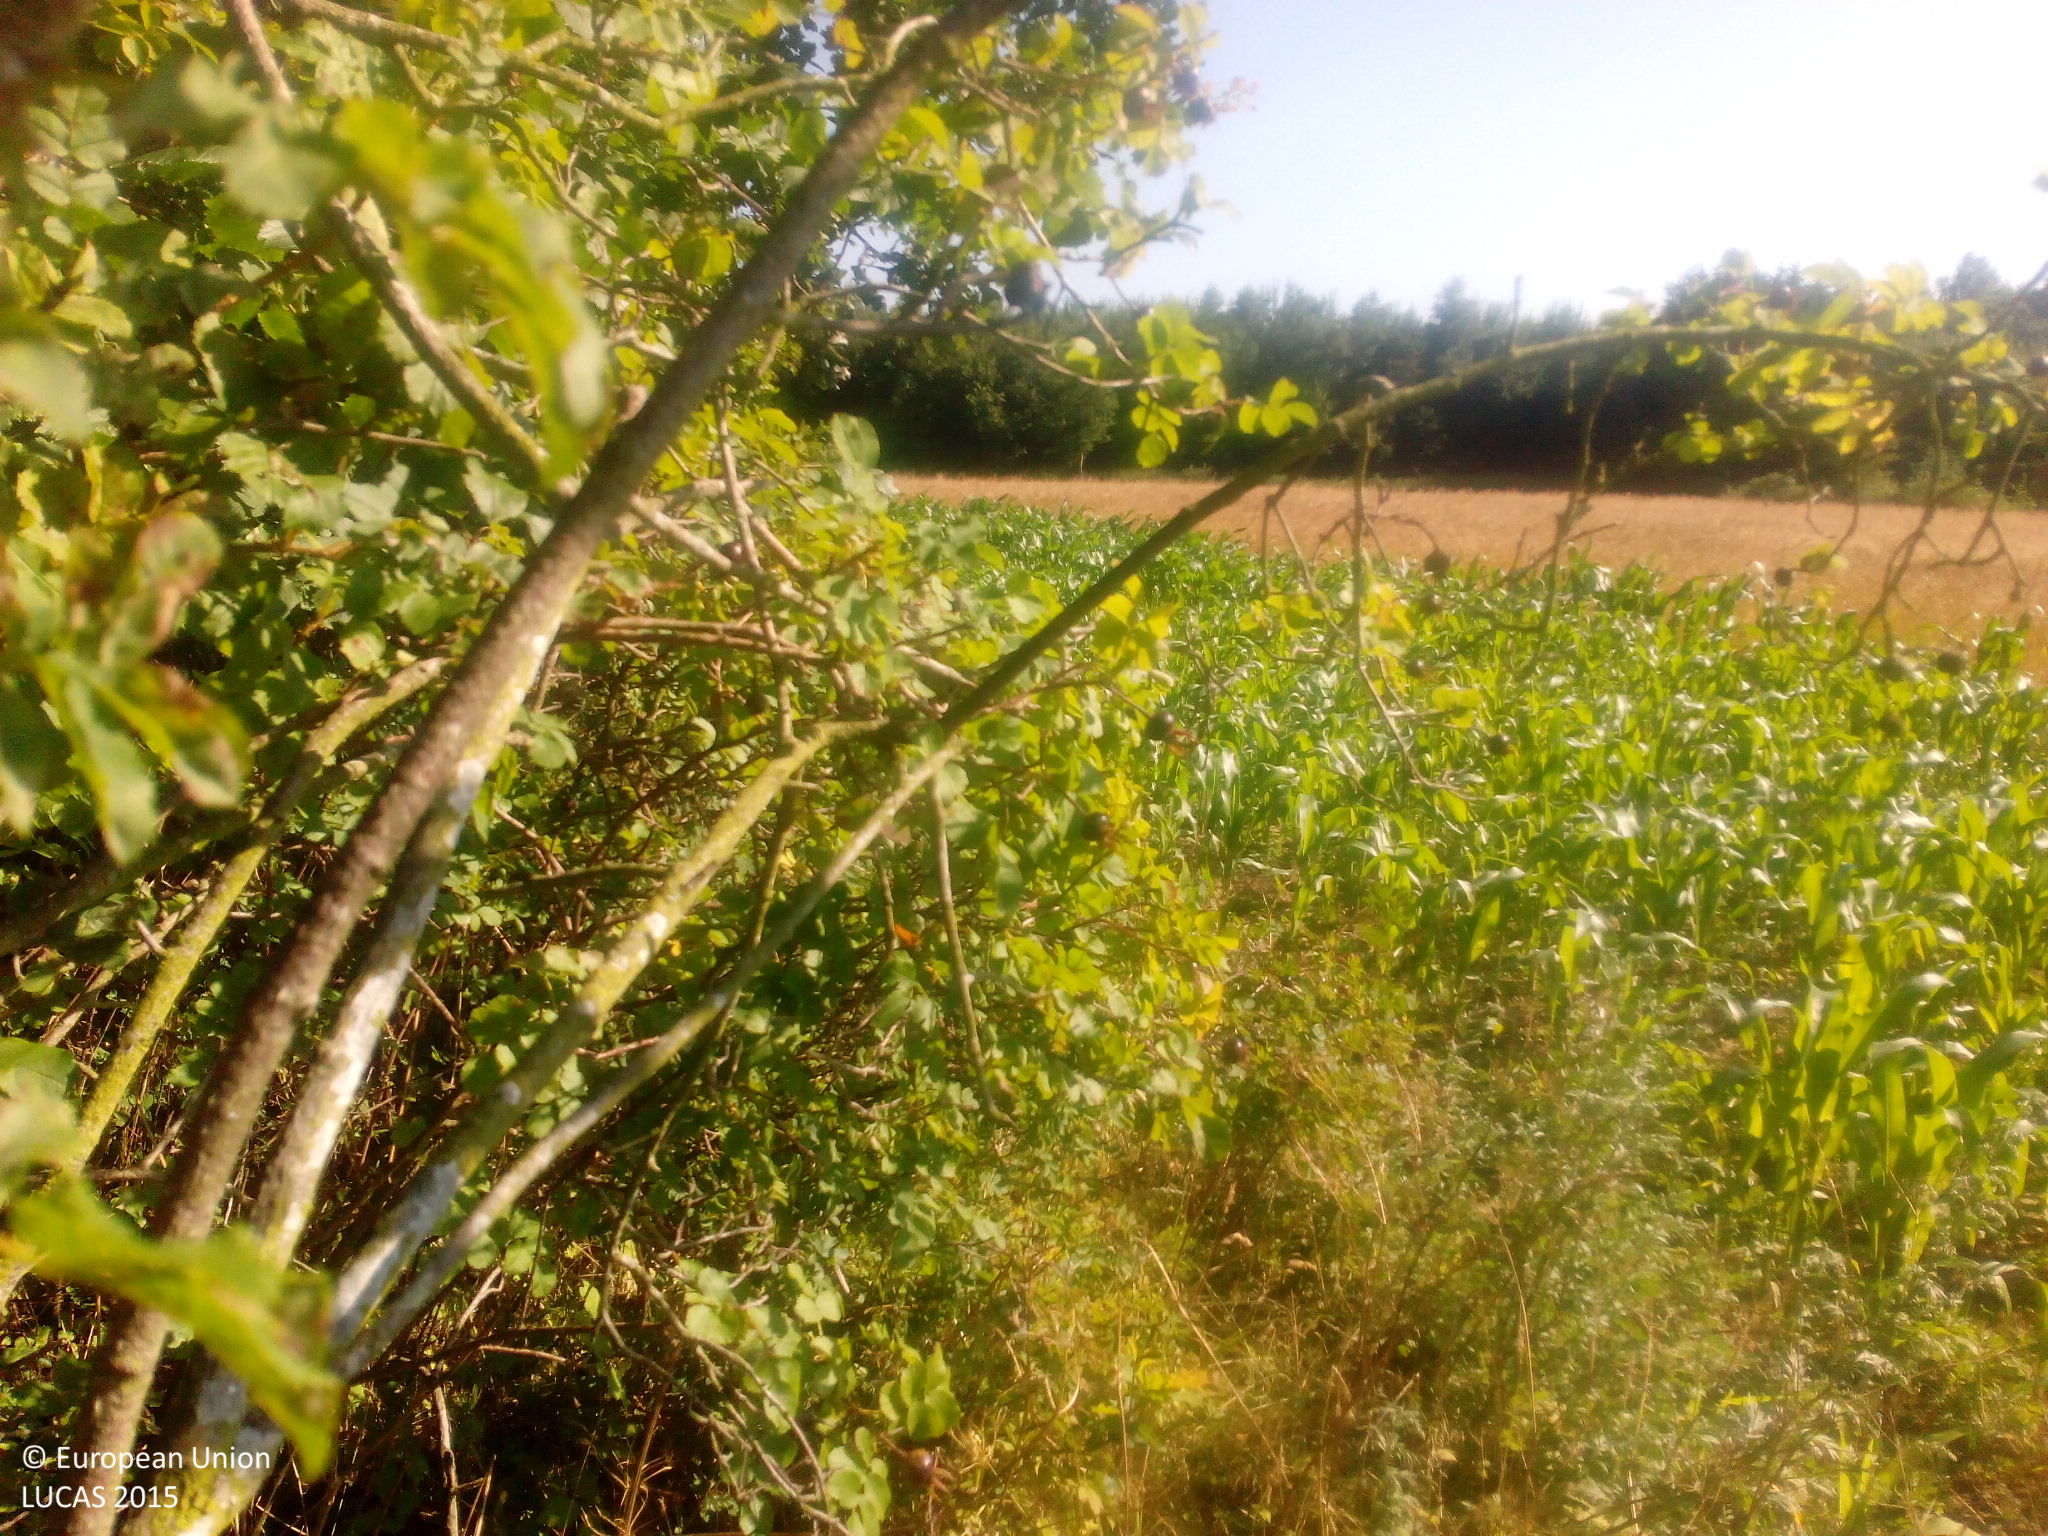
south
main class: Woodland
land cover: Spruce dominated mixed woodland
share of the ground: > 75 %
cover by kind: coniferous forest trees 60 %, broadleaved forest trees 40 %
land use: Semi-natural and natural areas not in use
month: August
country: DK
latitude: 55.6547
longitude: 11.7308
